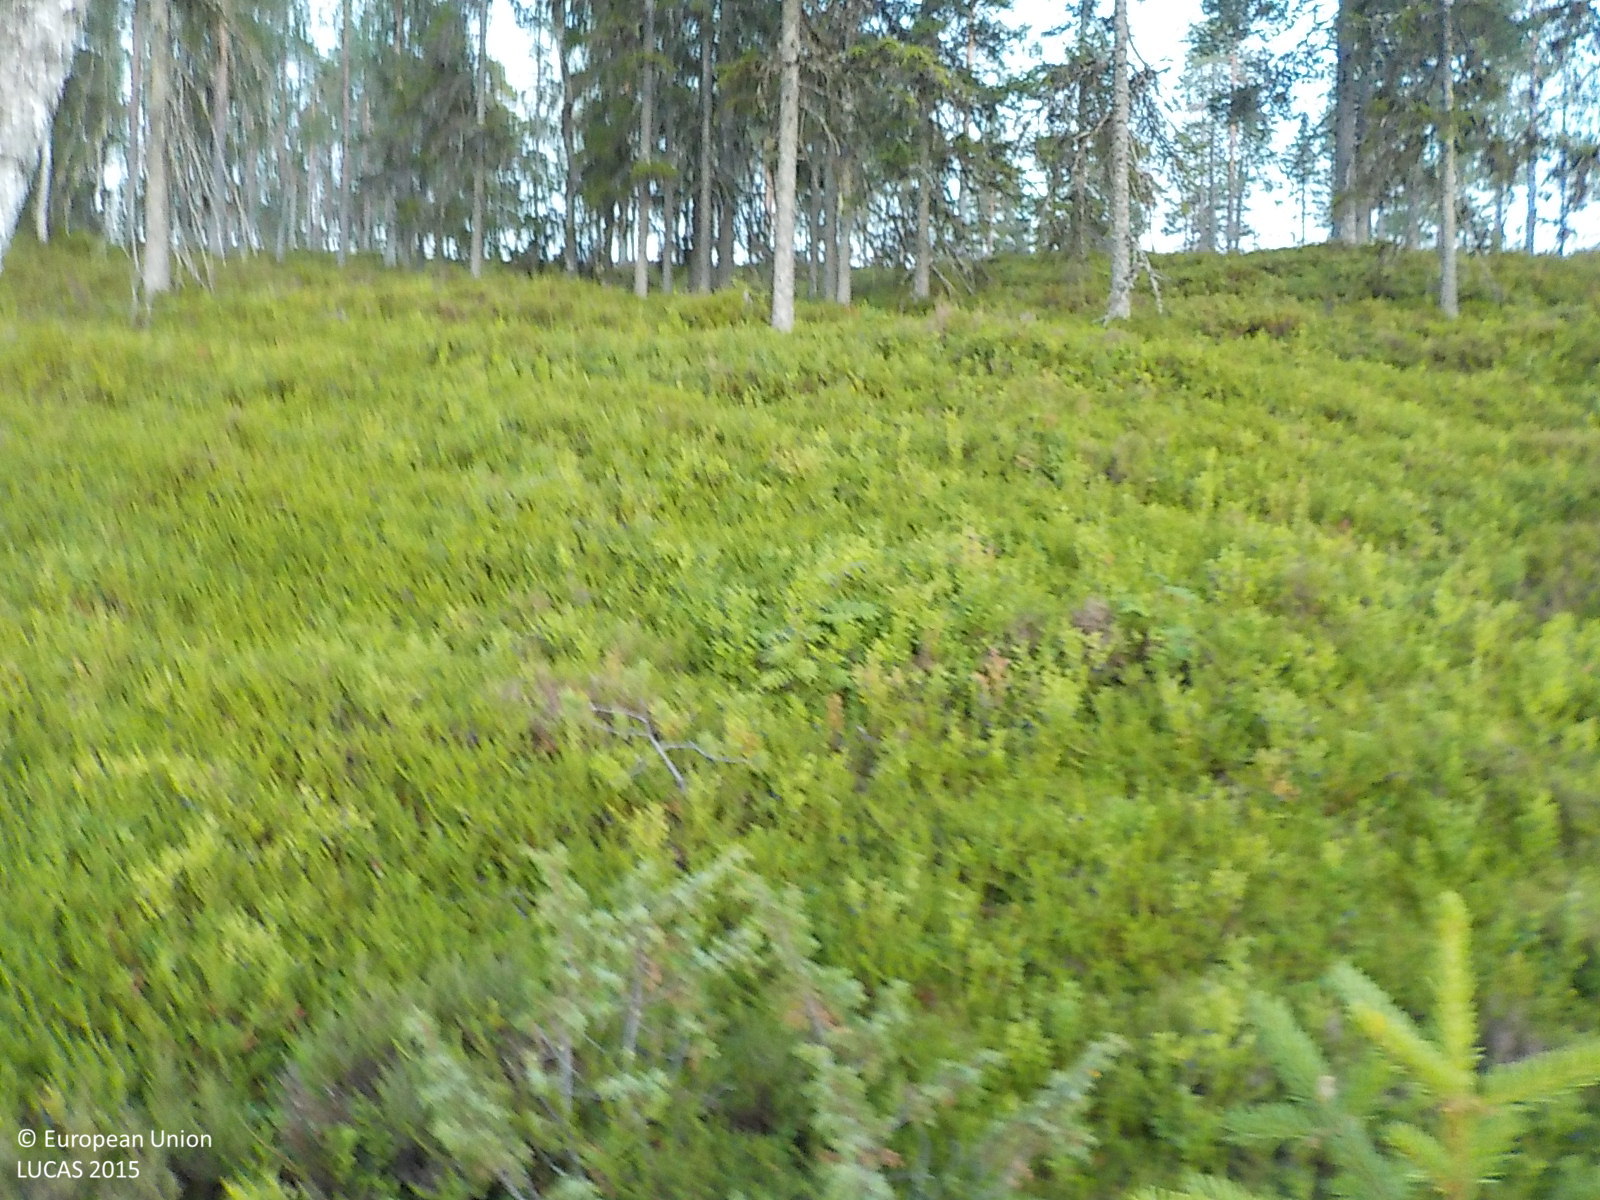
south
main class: Woodland
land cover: Pine dominated mixed woodland
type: boreal forest
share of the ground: 10 - 25 %
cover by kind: shrubs 80 %, coniferous forest trees 15 %, broadleaved forest trees 5 %
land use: Forestry
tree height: > 5 m
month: August
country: SE
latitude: 63.4792
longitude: 18.8296
